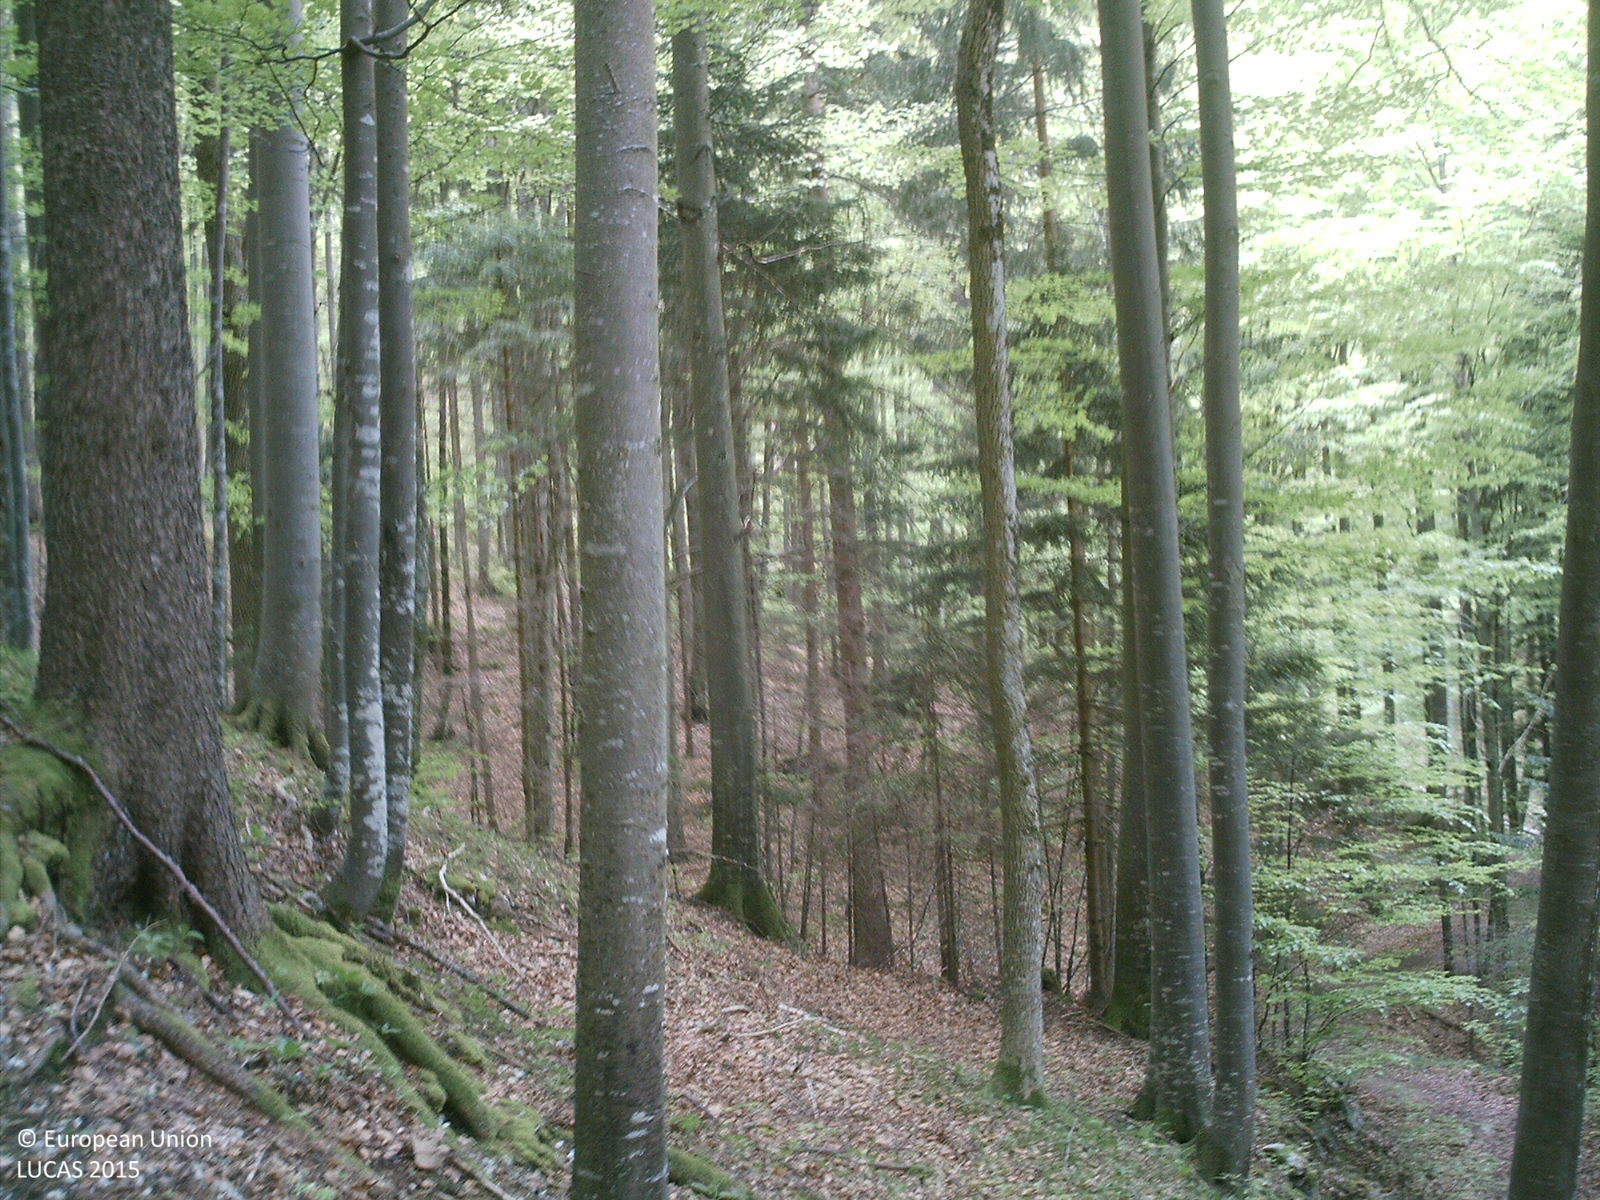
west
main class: Woodland
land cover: Other mixed woodland
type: mountainous beech forest
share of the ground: > 75 %
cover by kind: broadleaved forest trees 75 %, coniferous forest trees 25 %
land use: Forestry
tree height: > 5 m
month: May
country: AT
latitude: 47.8798
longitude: 14.0241
